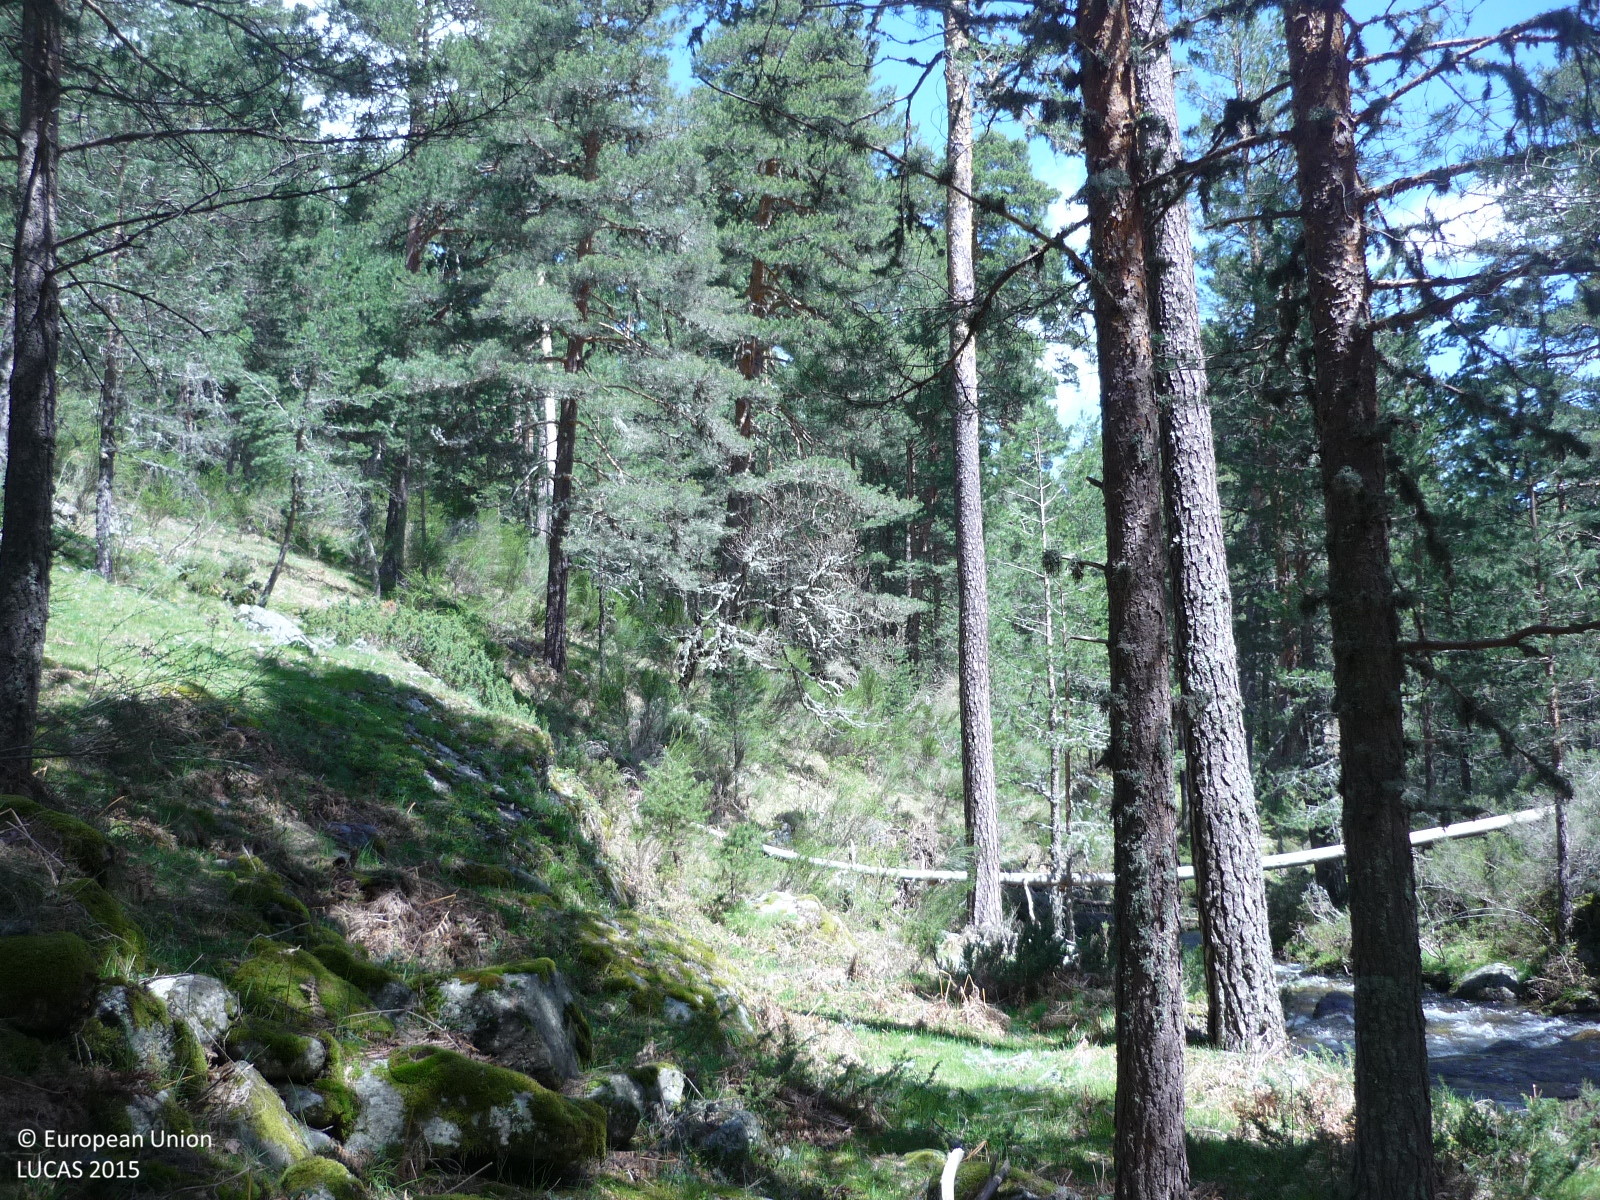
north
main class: Woodland
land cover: Pine dominated coniferous woodland
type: coniferous forest of the mediterranean region
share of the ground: > 75 %
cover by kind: coniferous forest trees 85 %, shrubs 10 %, herbaceous plants 5 %
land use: Forestry
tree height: > 5 m
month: May
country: ES
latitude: 40.8256
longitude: -3.9308
